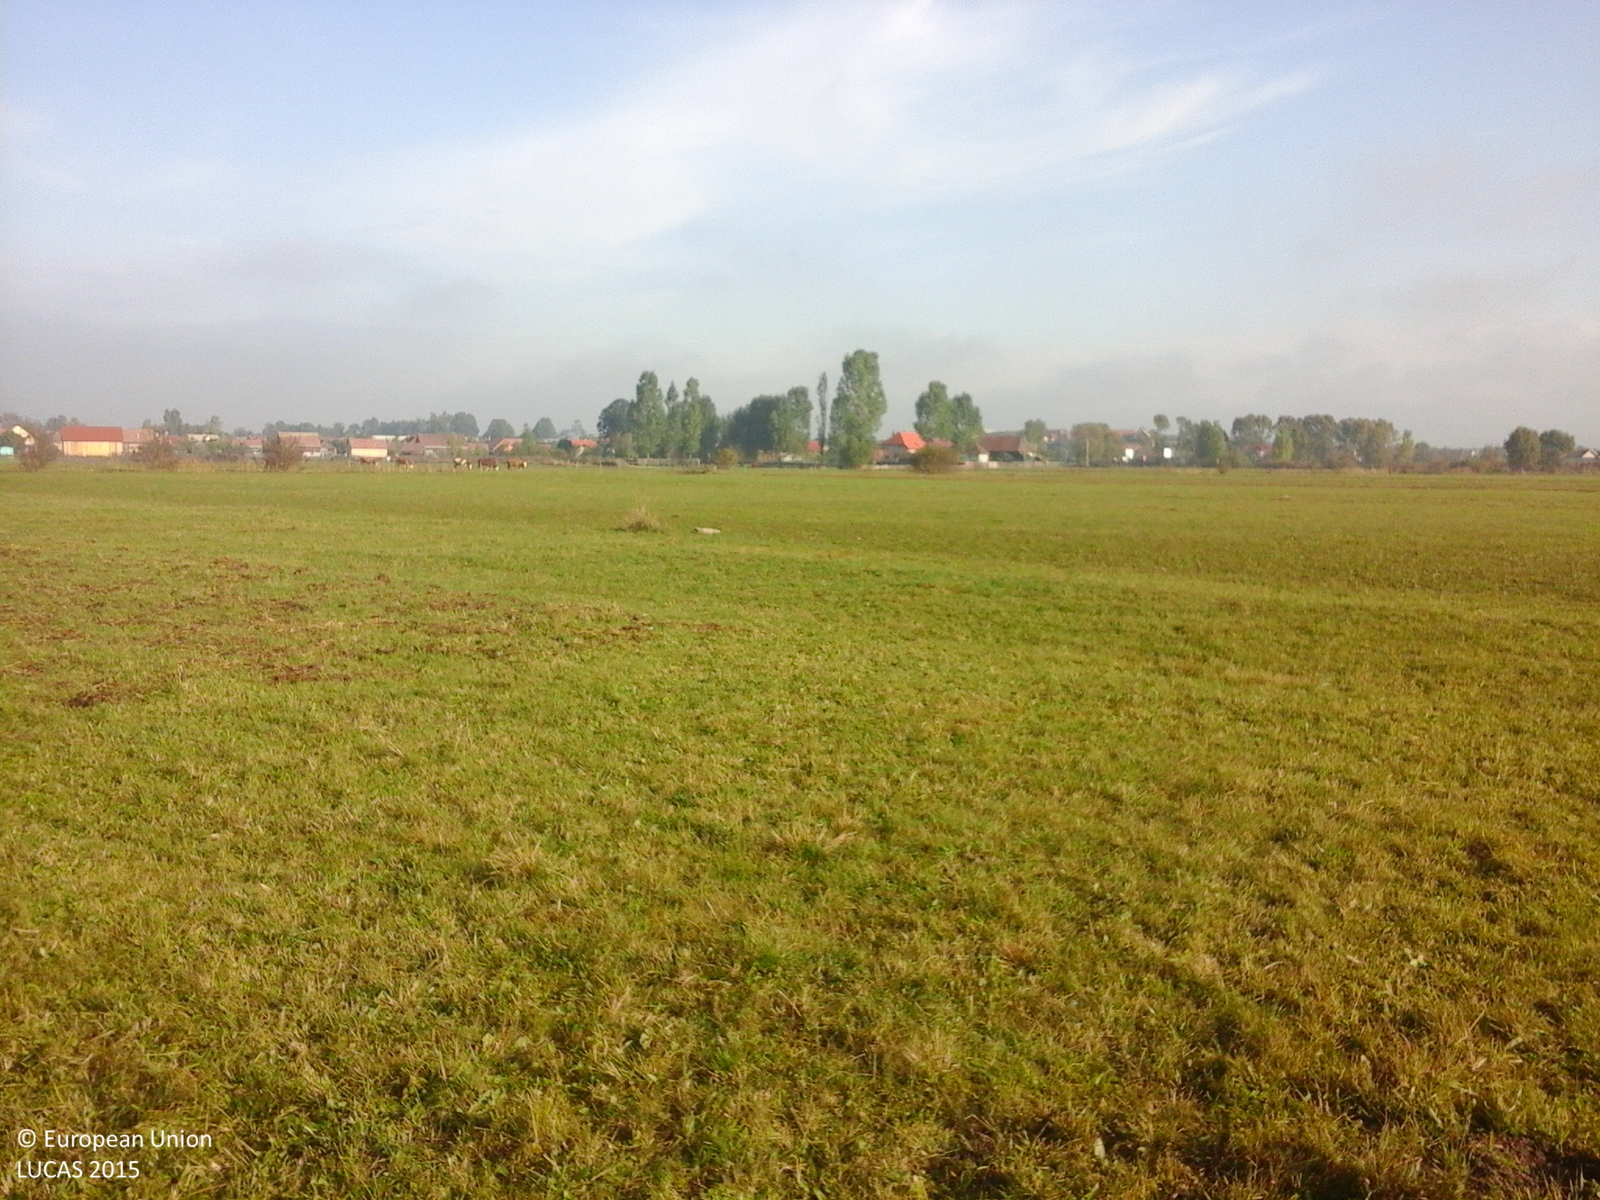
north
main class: Grassland
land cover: Grassland without tree/shrub cover
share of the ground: > 75 %
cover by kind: herbaceous plants 100 %
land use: Agriculture (excluding fallow land and kitchen gardens)
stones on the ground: < 10 %
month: October
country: RO
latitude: 46.2348
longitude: 25.8977
